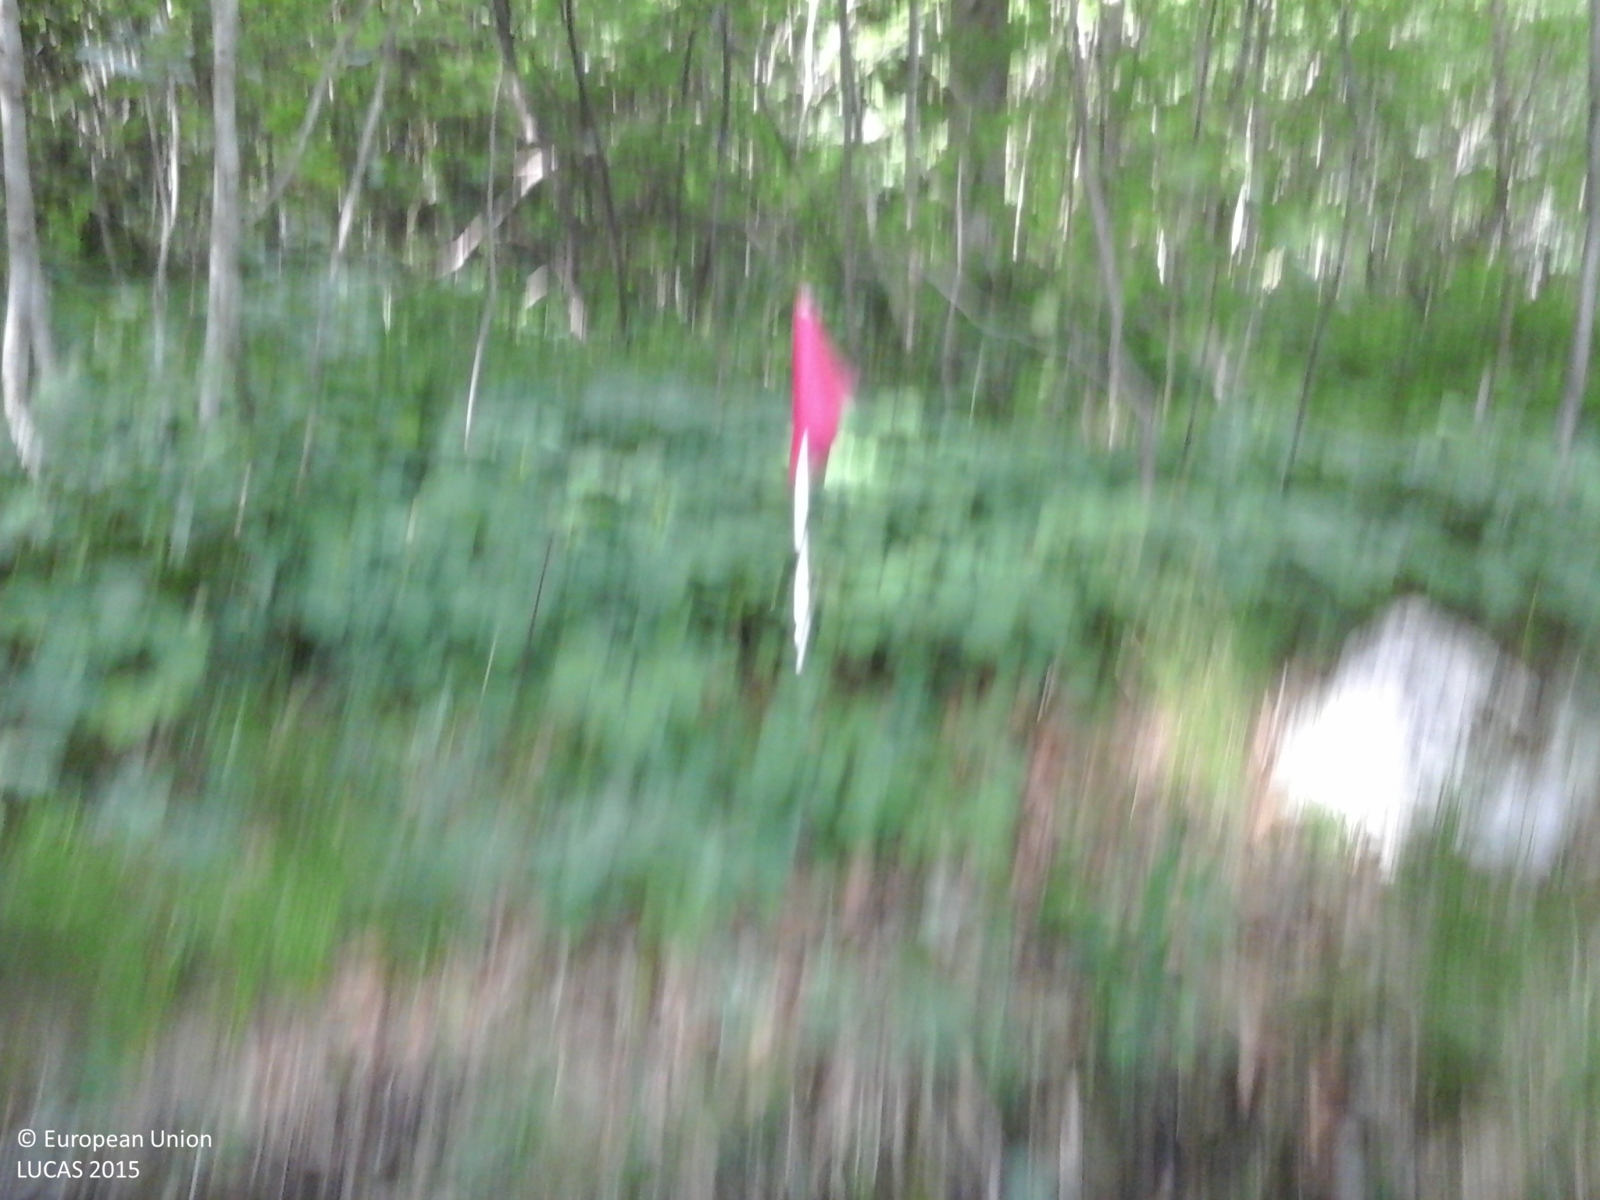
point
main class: Woodland
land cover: Broadleaved woodland
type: mountainous beech forest
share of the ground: > 75 %
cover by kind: broadleaved forest trees 100 %
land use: Forestry
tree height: > 5 m
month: May
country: IT
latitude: 45.7701
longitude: 10.9886
